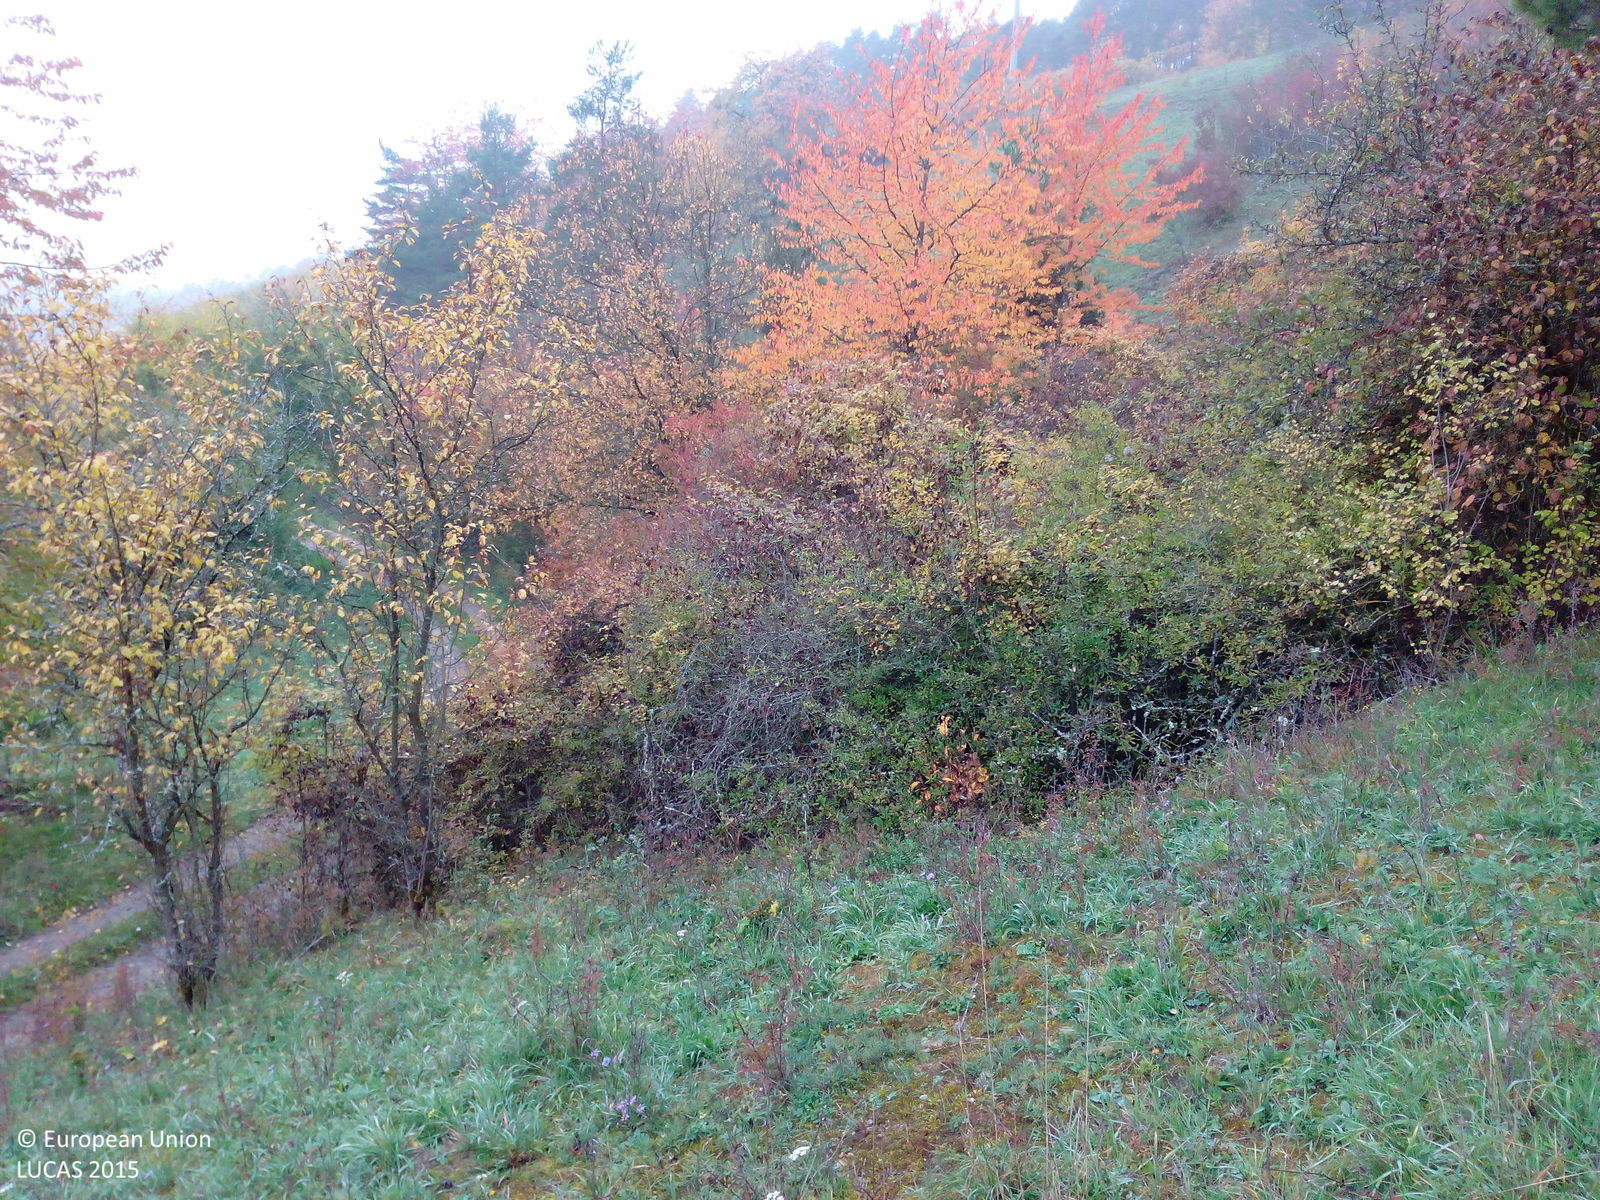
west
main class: Grassland
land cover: Grassland with sparse tree/shrub cover
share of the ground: > 75 %
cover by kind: herbaceous plants 90 %, coniferous forest trees 5 %, lichens and mosses 5 %
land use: Semi-natural and natural areas not in use
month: October
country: DE
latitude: 50.1482
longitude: 9.9301
